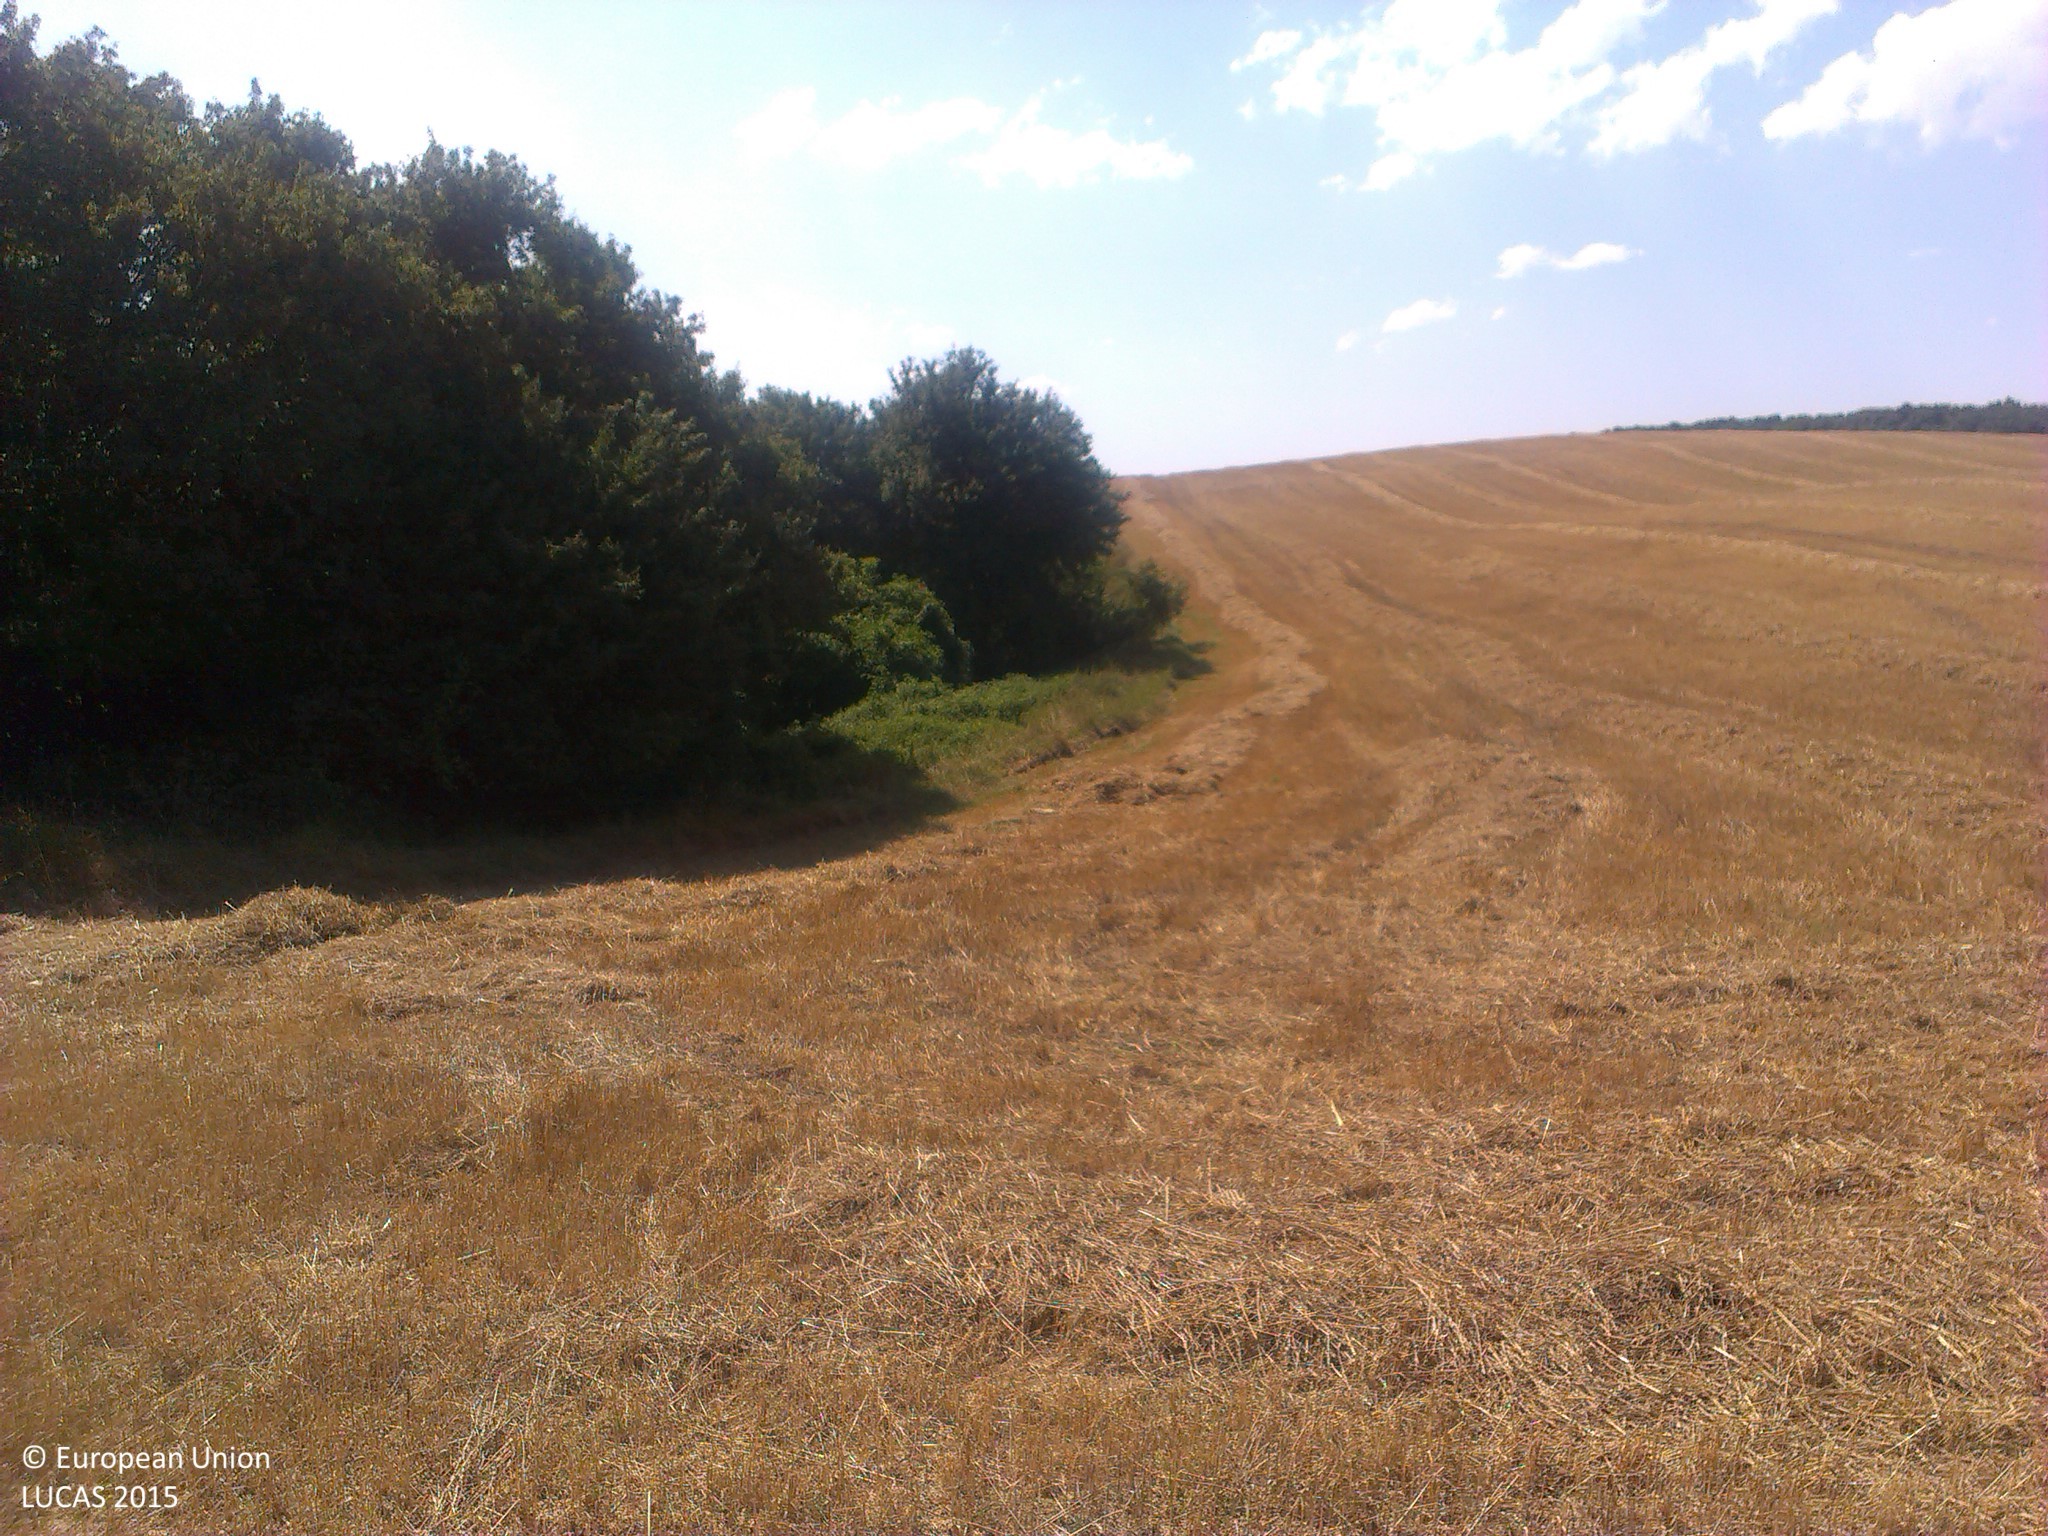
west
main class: Cropland
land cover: Sunflower
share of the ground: > 75 %
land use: Agriculture (excluding fallow land and kitchen gardens)
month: August
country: ES
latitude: 42.8593
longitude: -2.5209
